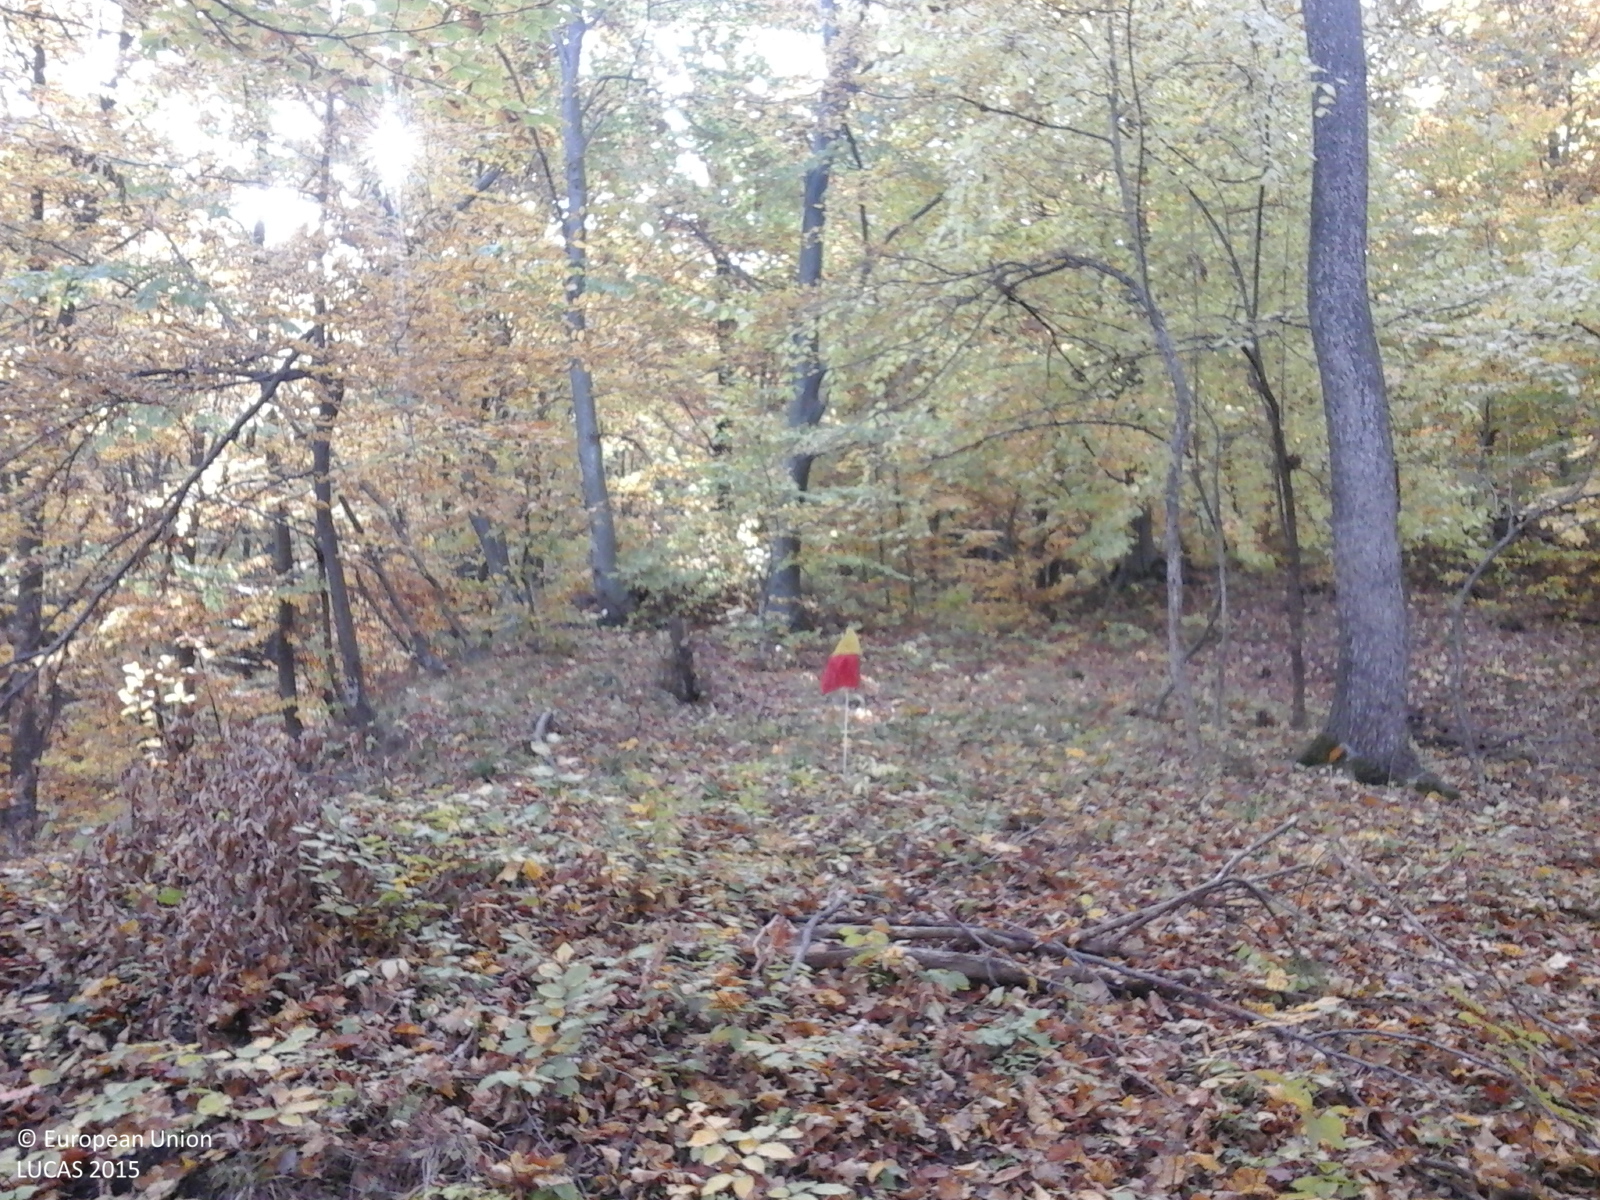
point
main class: Woodland
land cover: Broadleaved woodland
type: beech forest
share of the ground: > 75 %
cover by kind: broadleaved forest trees 100 %
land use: Forestry
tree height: > 5 m
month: October
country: RO
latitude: 45.6378
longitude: 27.0108
